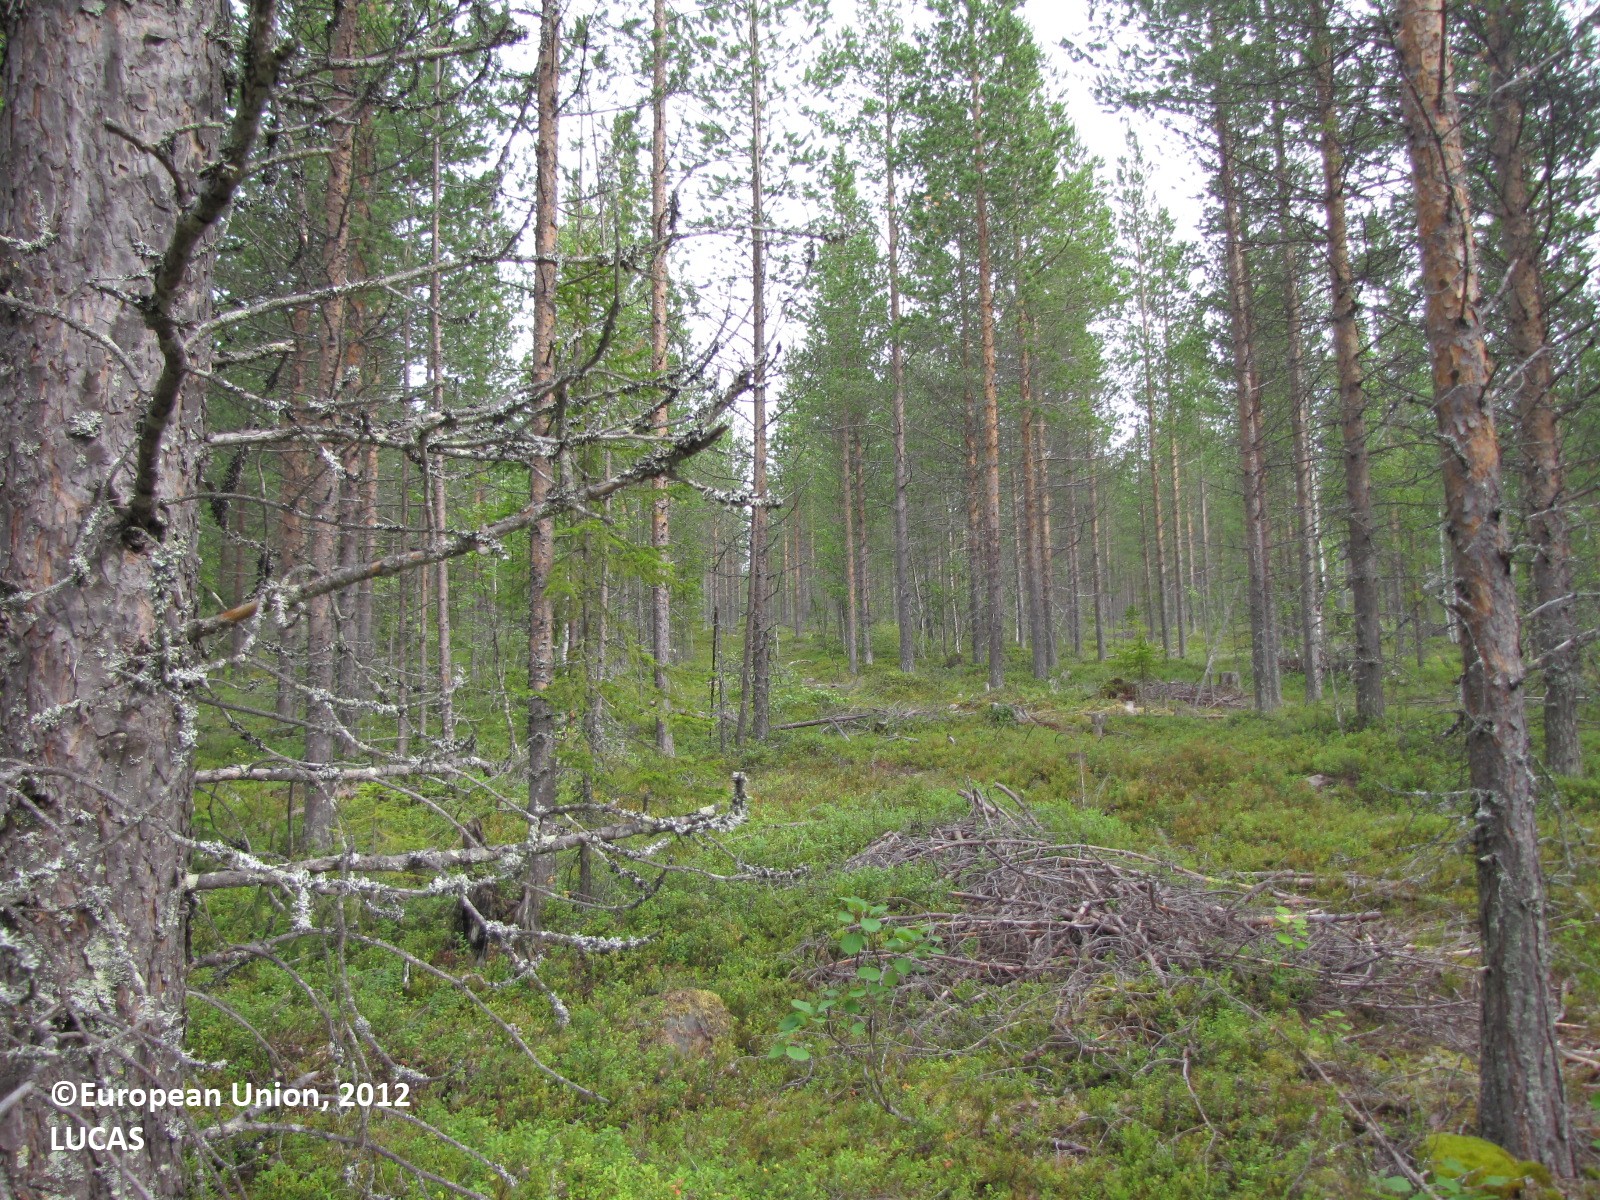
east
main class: Woodland
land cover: Pine dominated mixed woodland
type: boreal forest
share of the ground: 25 - 50 %
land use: Forestry
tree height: > 5 m
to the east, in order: Pine dominated mixed woodland; Pine dominated coniferous woodland; Pine dominated mixed woodland; Pine dominated coniferous woodland; Tracks; Grassland with sparse tree/shrub cover
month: August
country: FI
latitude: 66.8645
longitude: 24.9411
